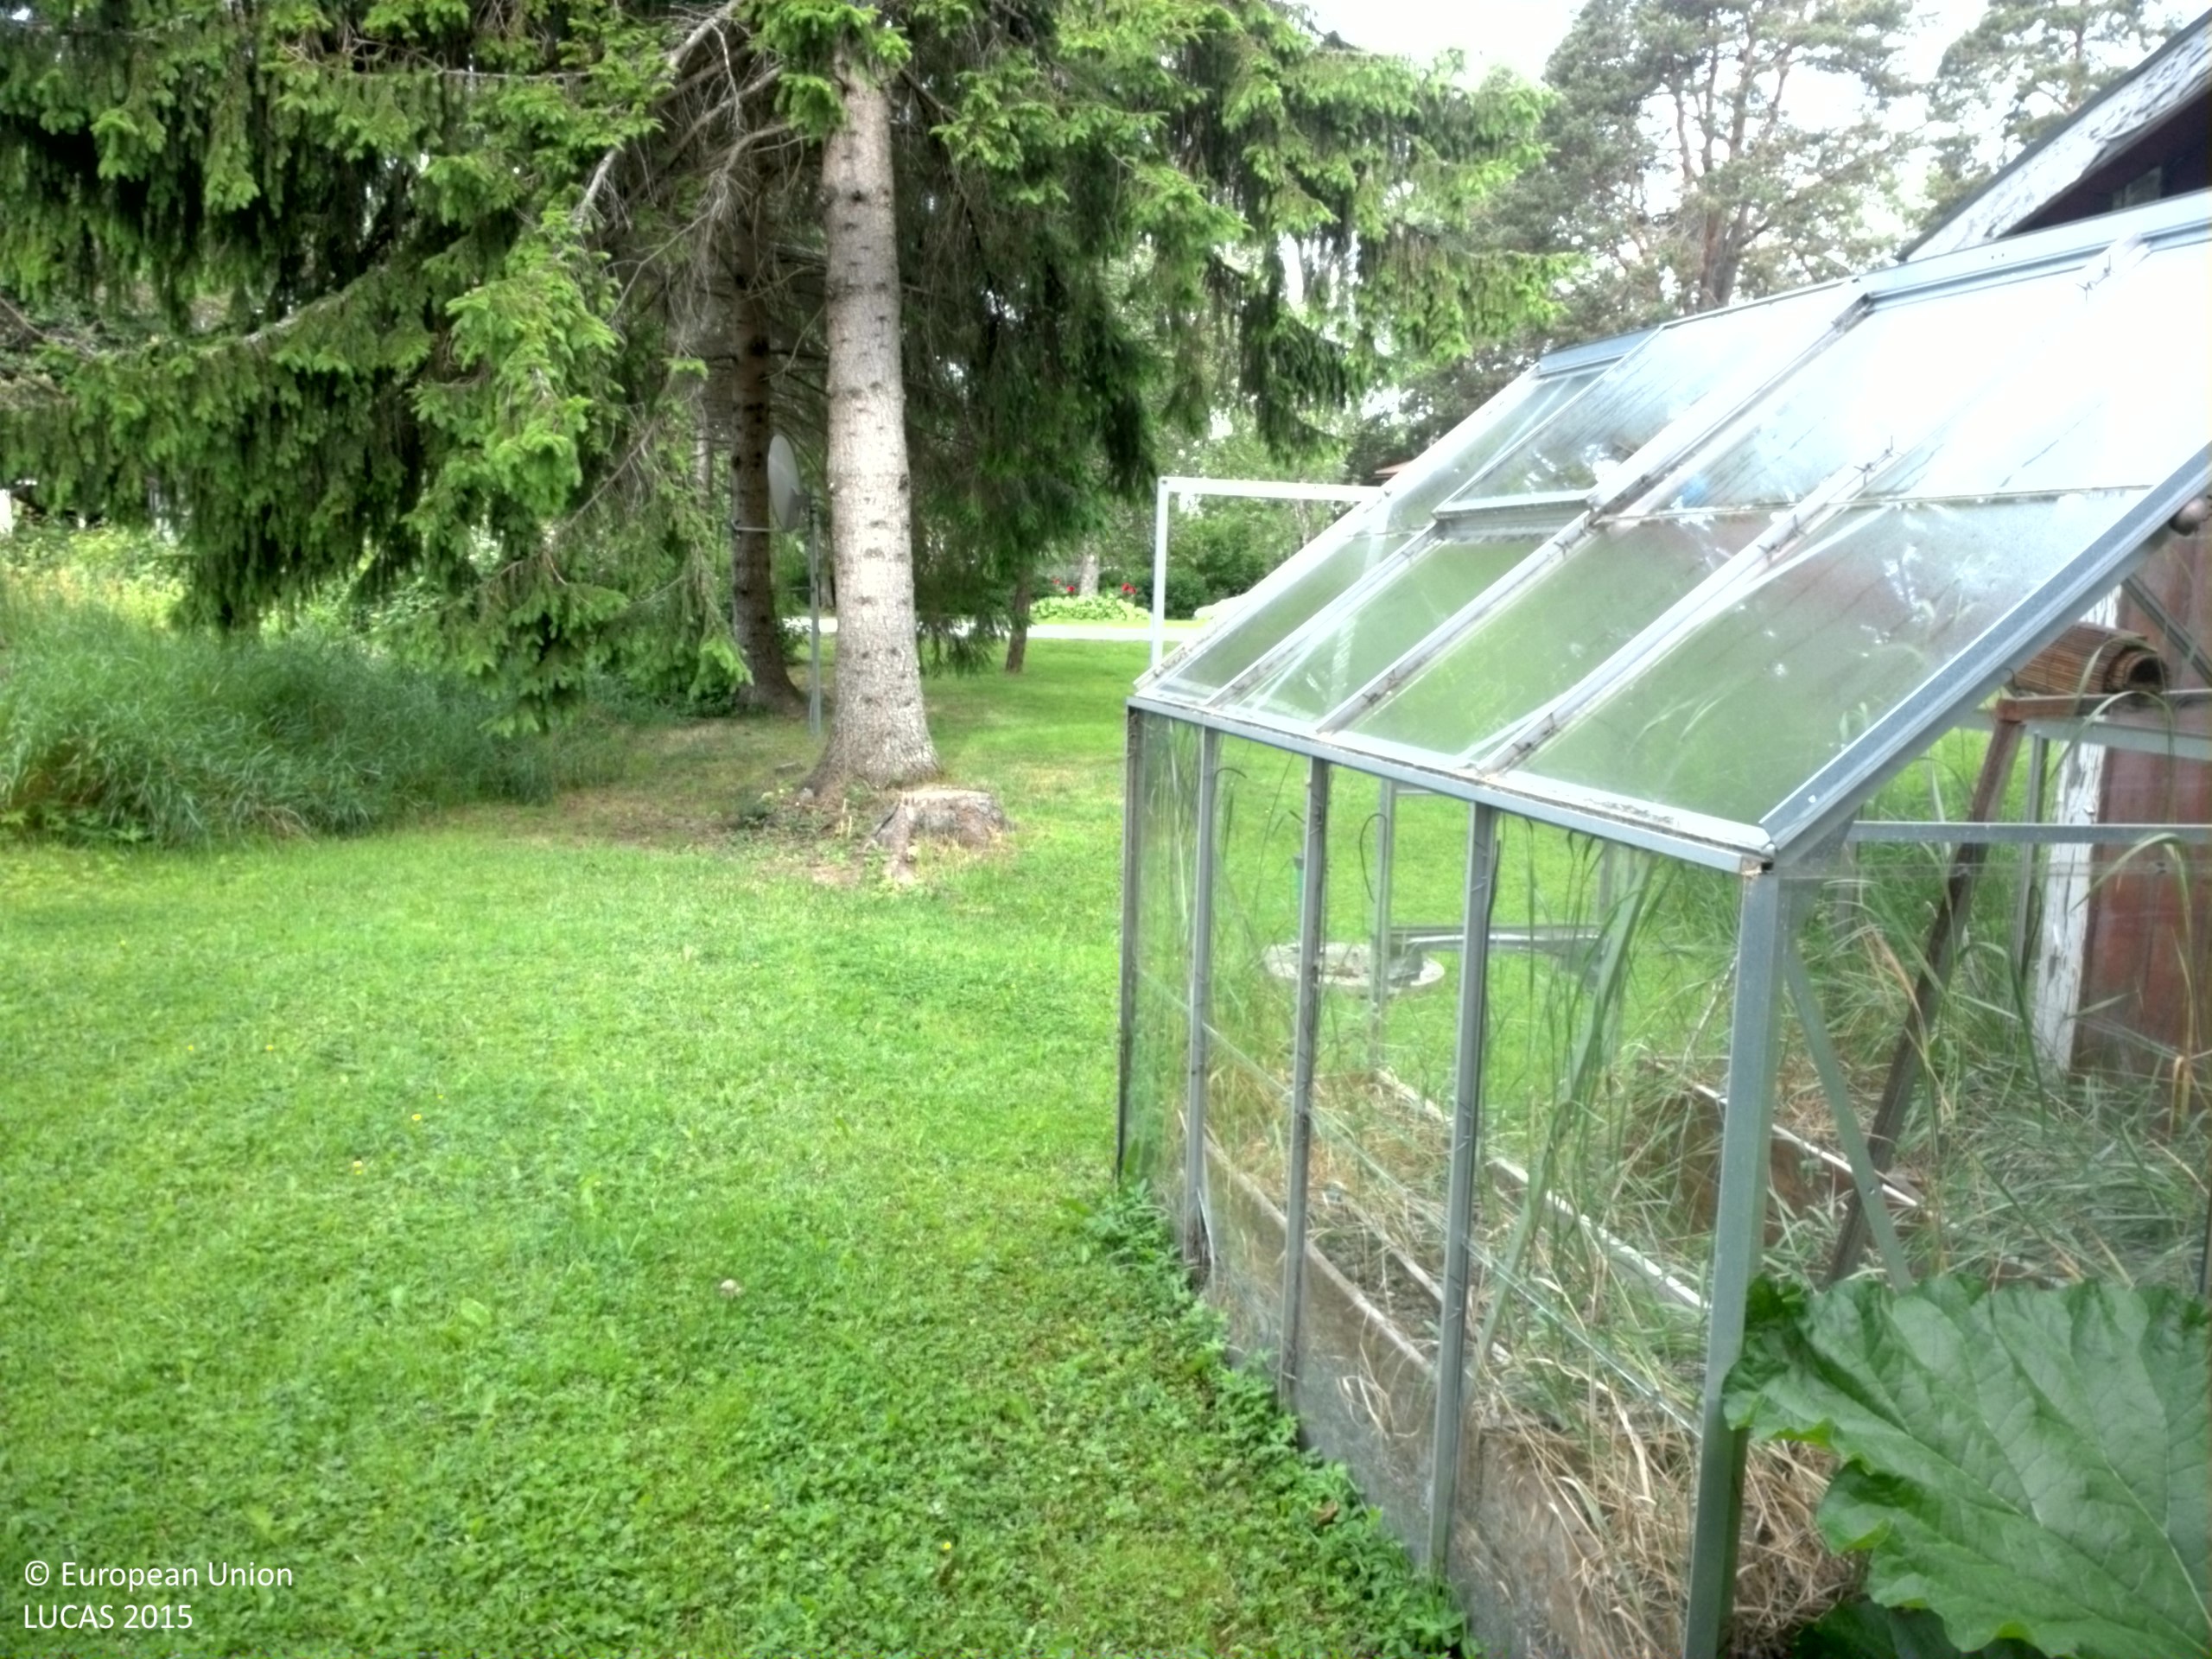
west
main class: Grassland
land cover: Grassland with sparse tree/shrub cover
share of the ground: > 75 %
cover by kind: herbaceous plants 80 %, shrubs 10 %, coniferous forest trees 5 %
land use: Residential
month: June
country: SE
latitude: 60.2215
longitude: 17.7369
